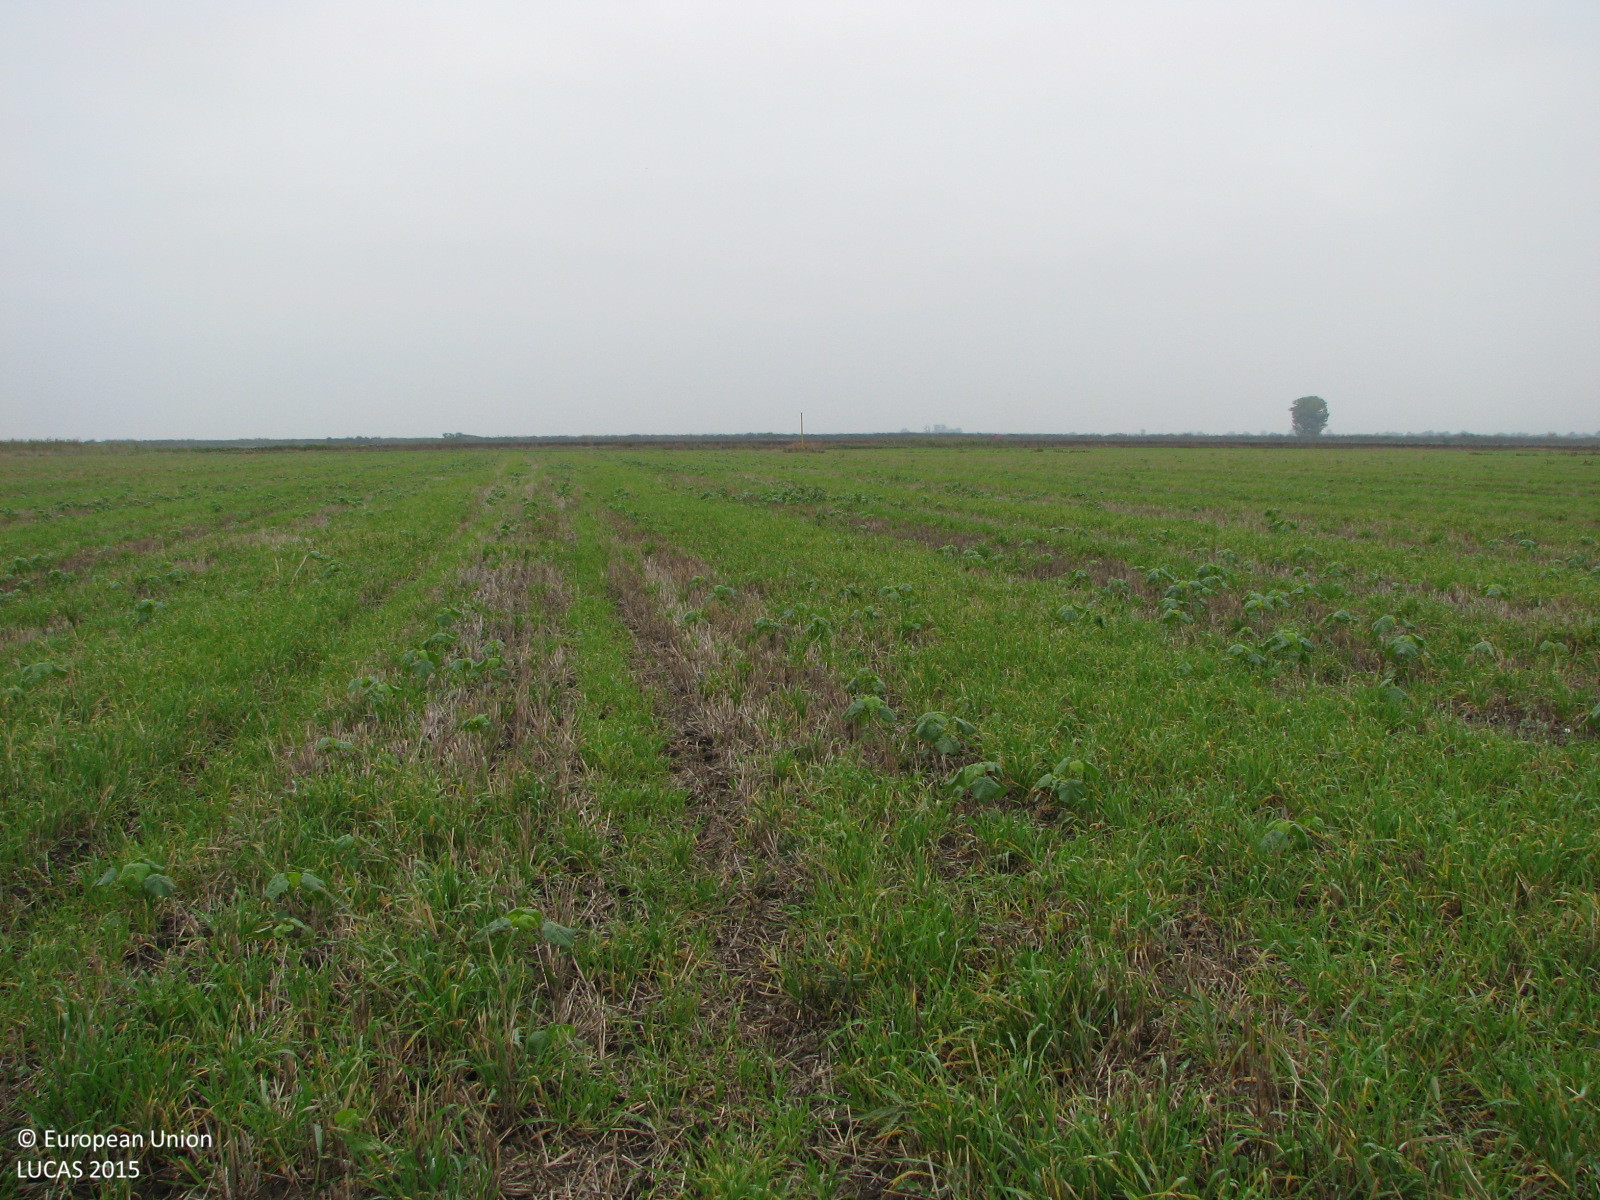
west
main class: Cropland
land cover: Common wheat
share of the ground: > 75 %
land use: Agriculture (excluding fallow land and kitchen gardens)
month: October
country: BG
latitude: 42.6287
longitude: 26.7441
